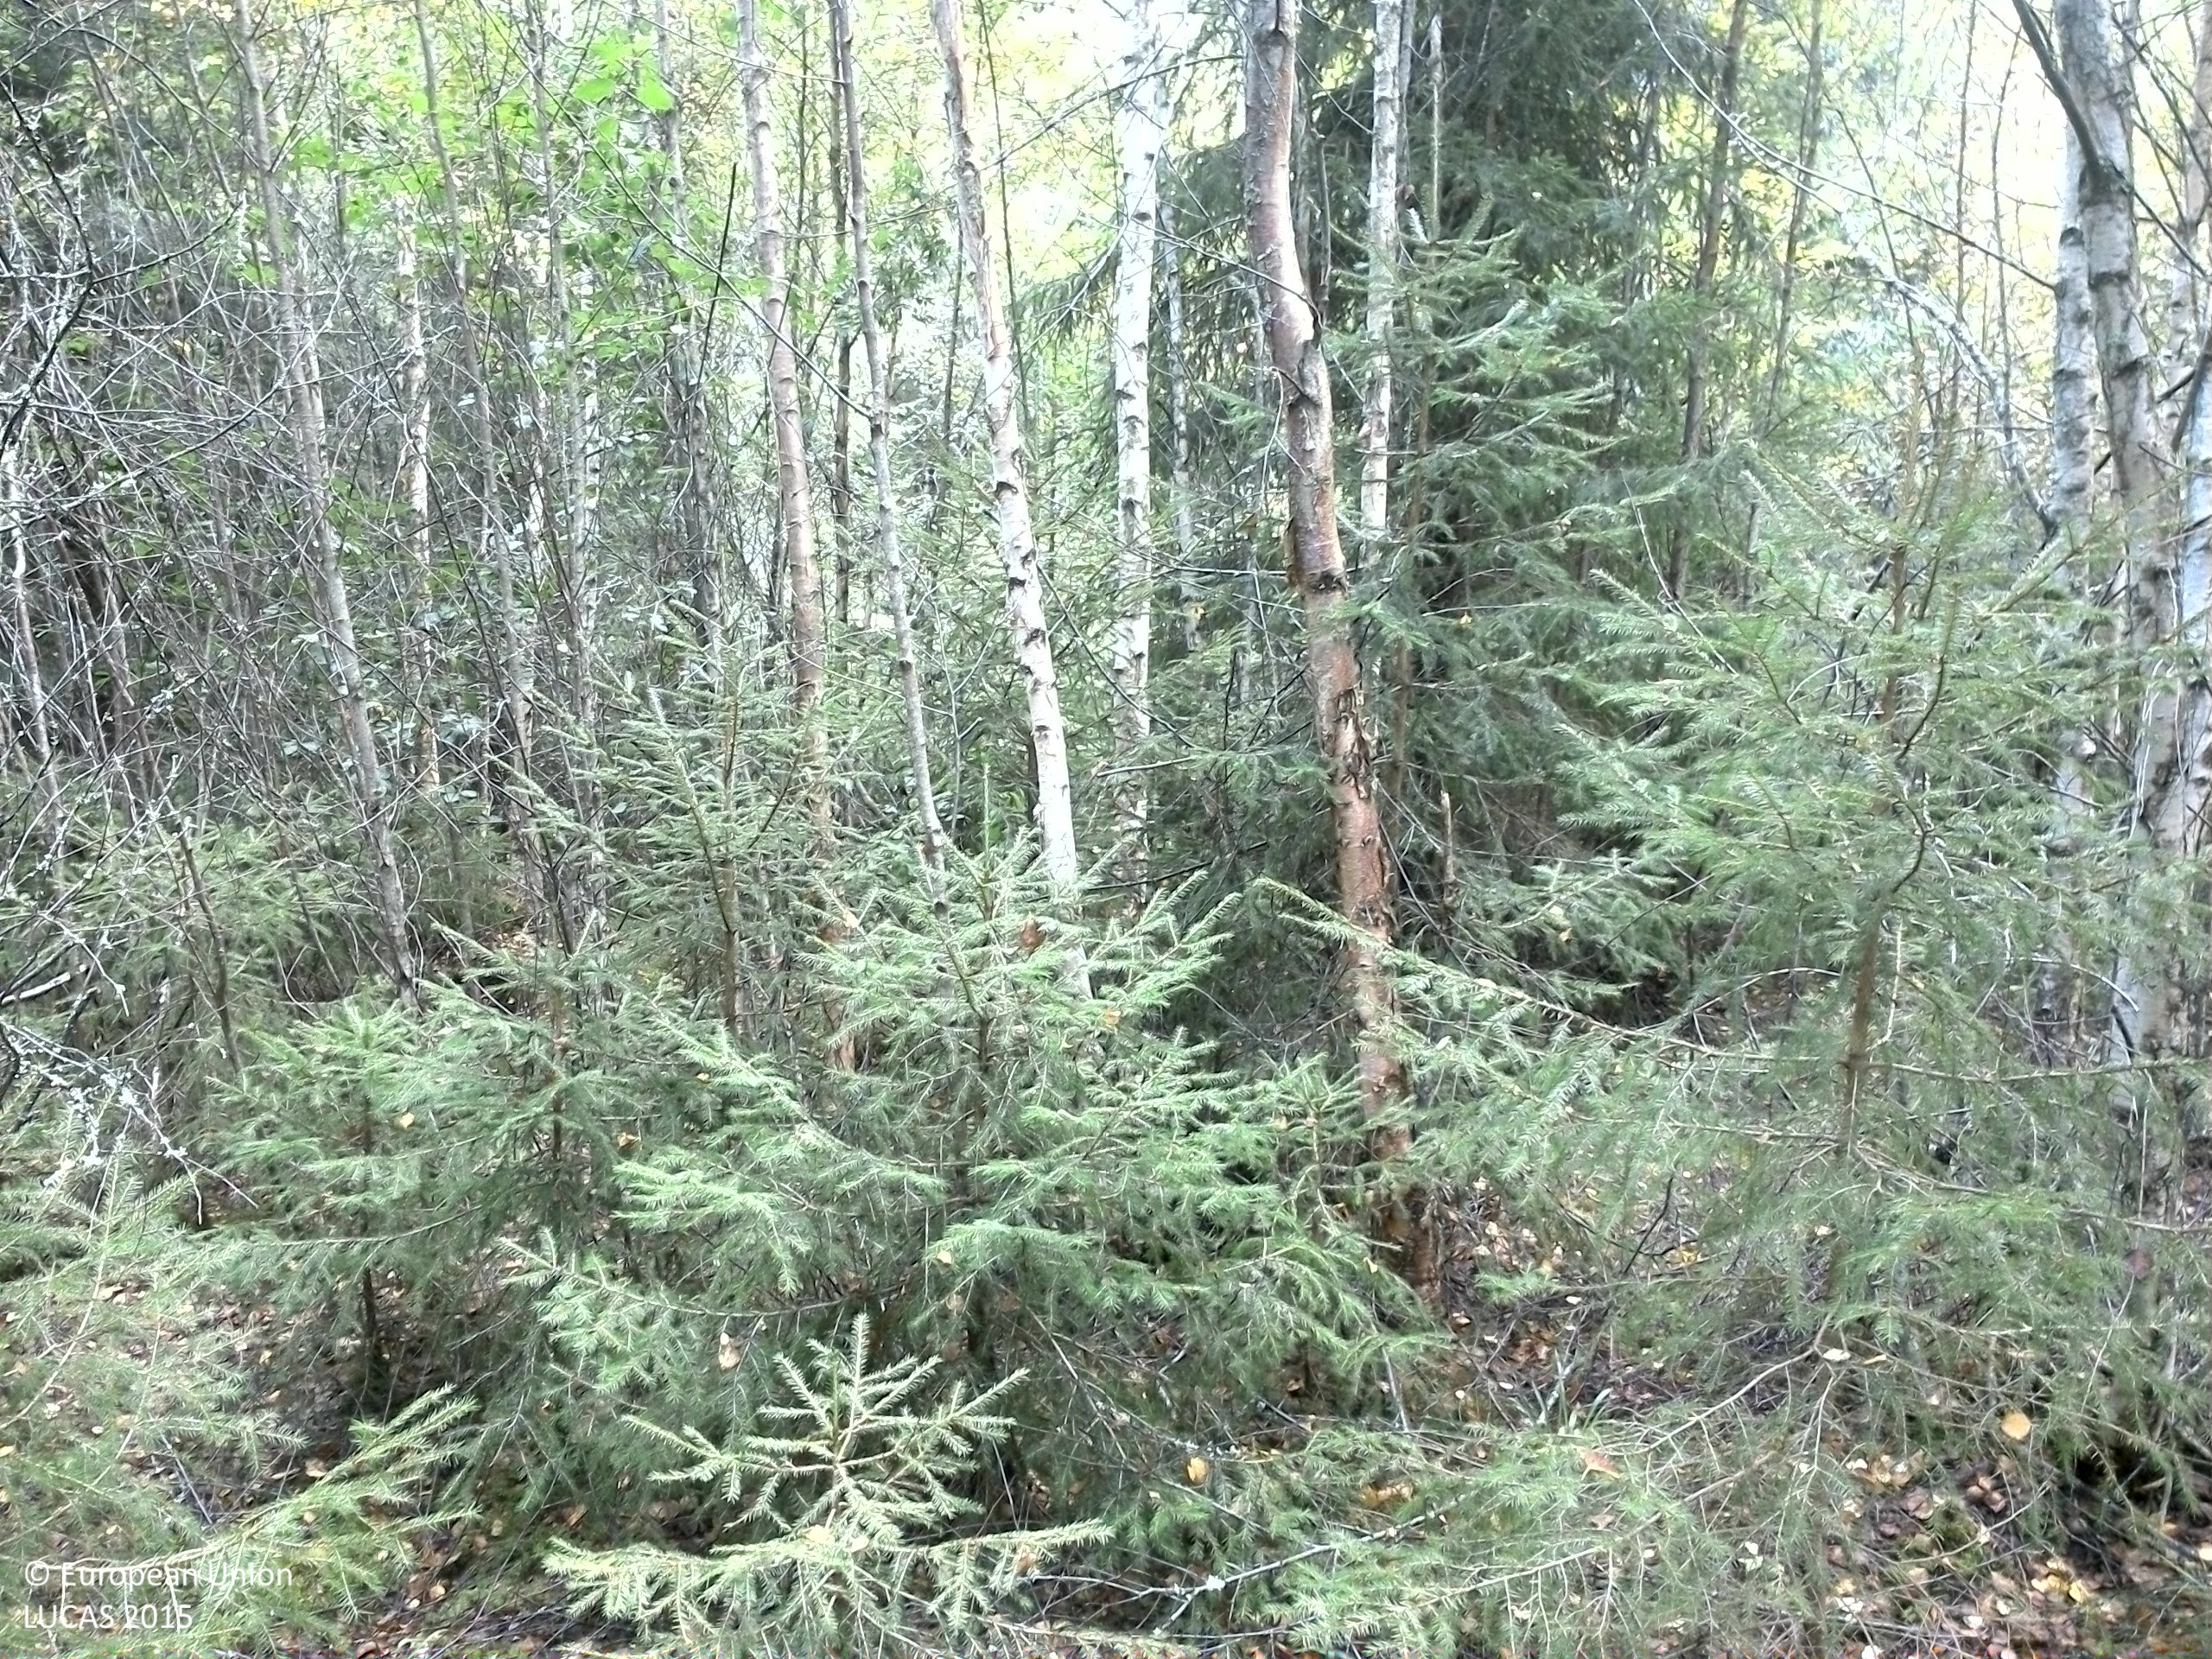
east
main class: Woodland
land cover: Spruce dominated mixed woodland
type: boreal forest
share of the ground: 50 - 75 %
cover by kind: coniferous forest trees 45 %, broadleaved forest trees 30 %, herbaceous plants 15 %, lichens and mosses 10 %
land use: Forestry
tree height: > 5 m
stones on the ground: < 10 %
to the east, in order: Spruce dominated mixed woodland; Rivers and streams; Spruce dominated coniferous woodland; Tracks; Spruce dominated coniferous woodland; Pine dominated coniferous woodland; Tracks; Pine dominated coniferous woodland; Tracks; Pine dominated coniferous woodland; Spruce dominated coniferous woodland; Spruce dominated mixed woodland
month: September
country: SE
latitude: 59.7665
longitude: 13.1789
